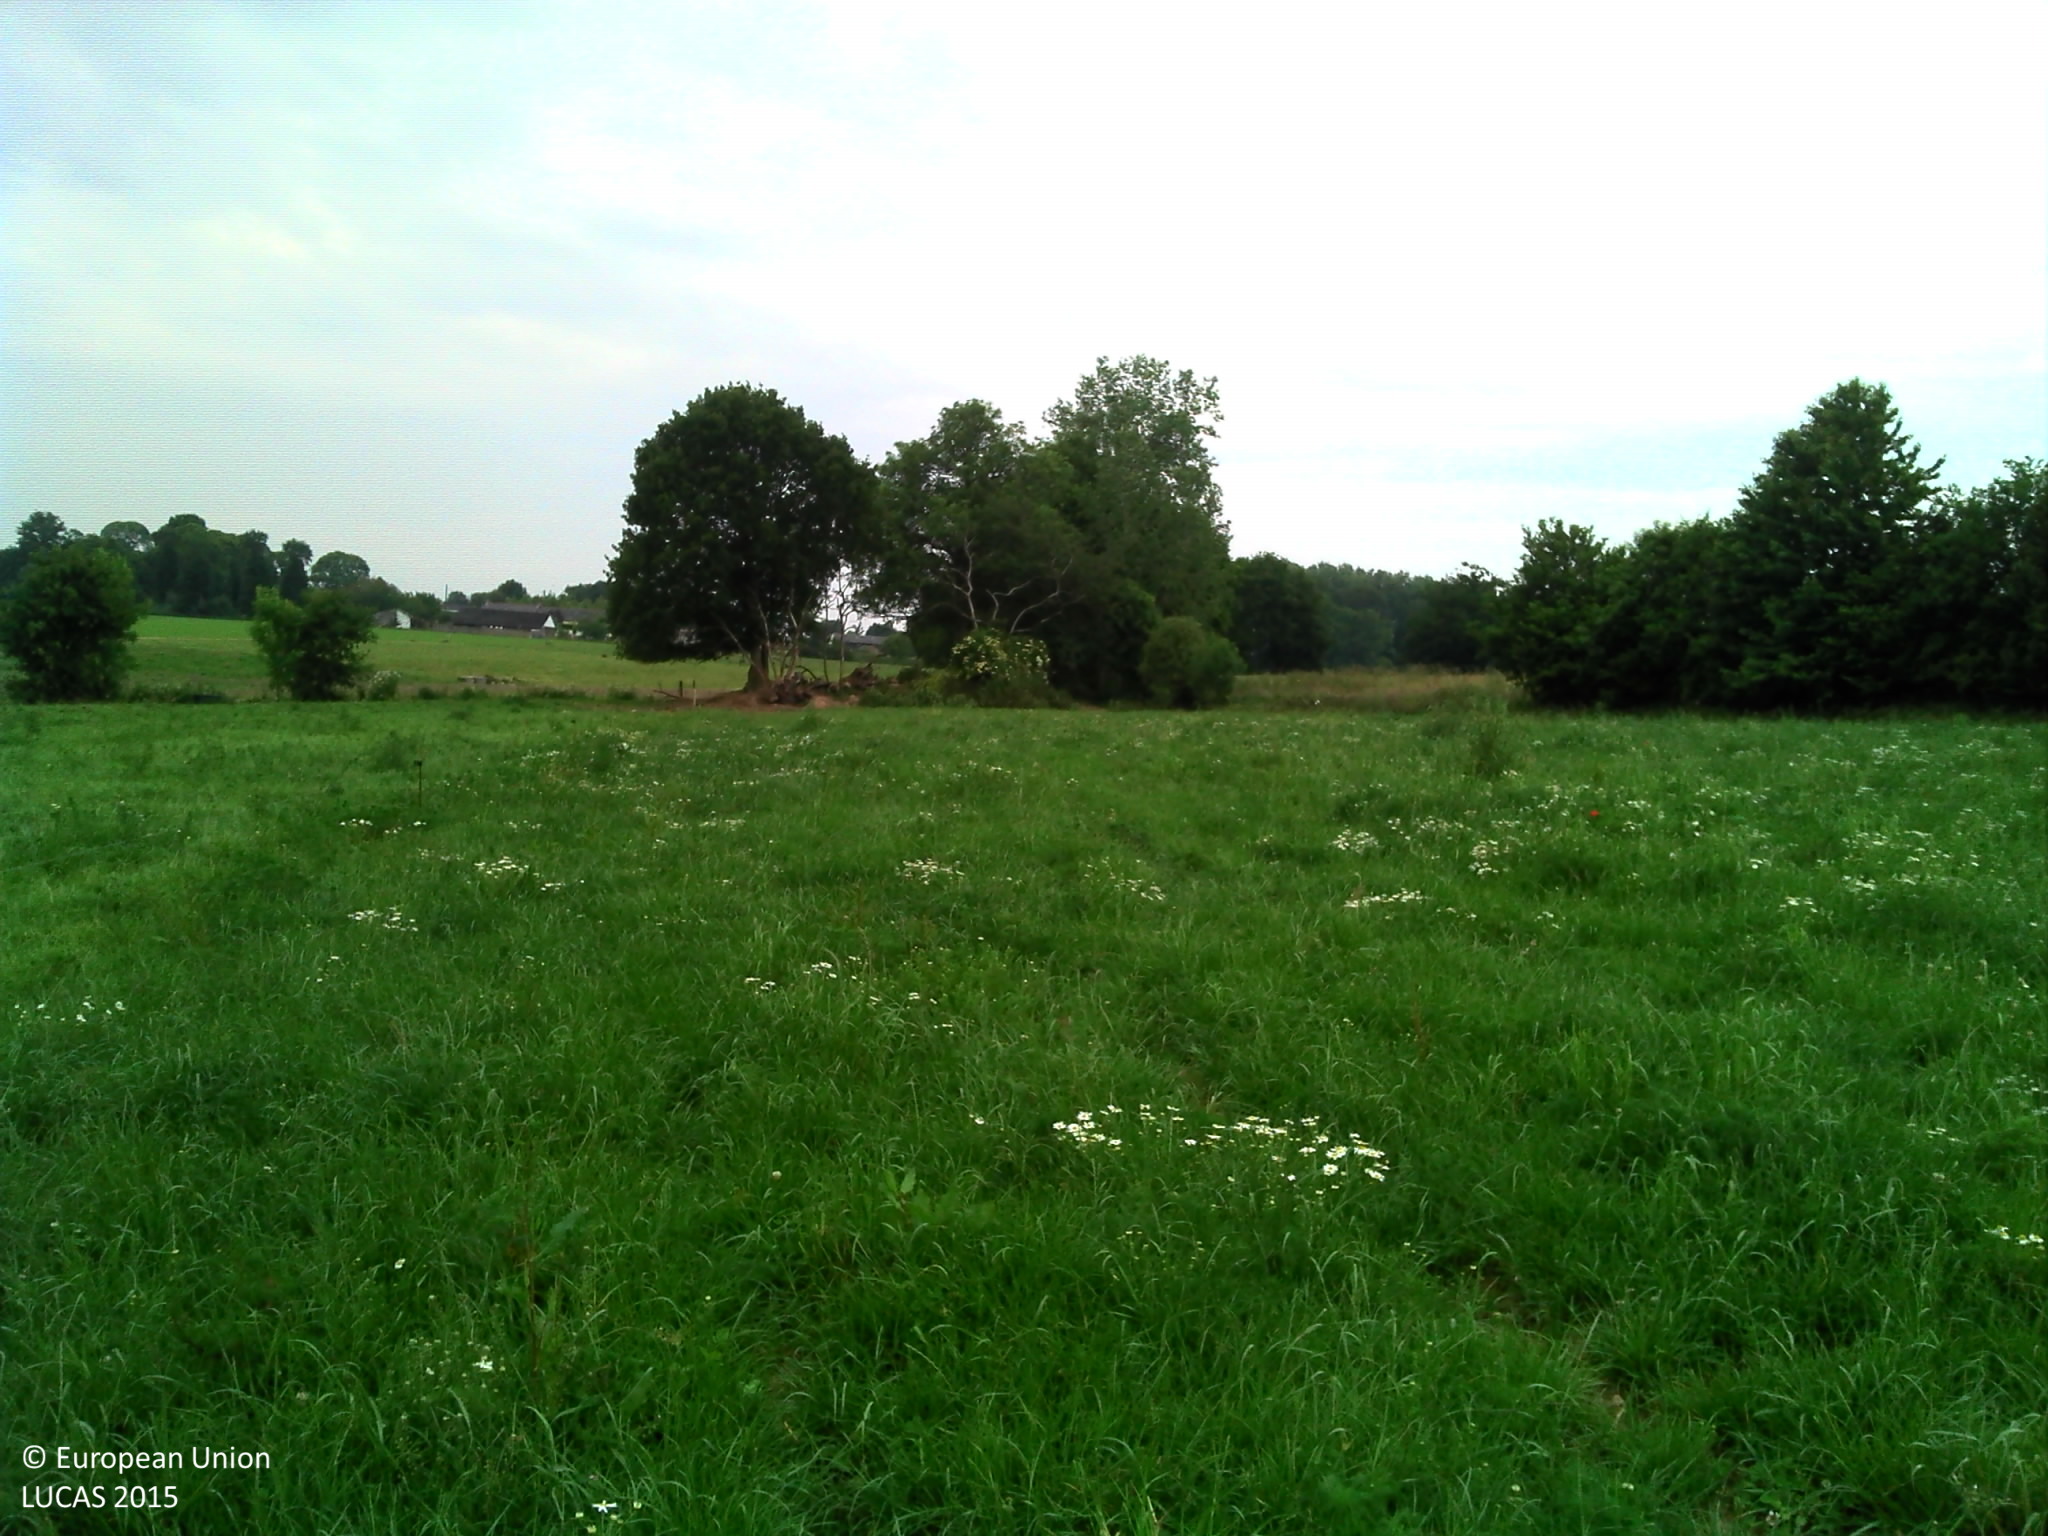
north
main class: Grassland
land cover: Grassland without tree/shrub cover
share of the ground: > 75 %
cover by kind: herbaceous plants 100 %
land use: Agriculture (excluding fallow land and kitchen gardens)
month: June
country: FR
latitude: 48.1562
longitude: -2.0856
